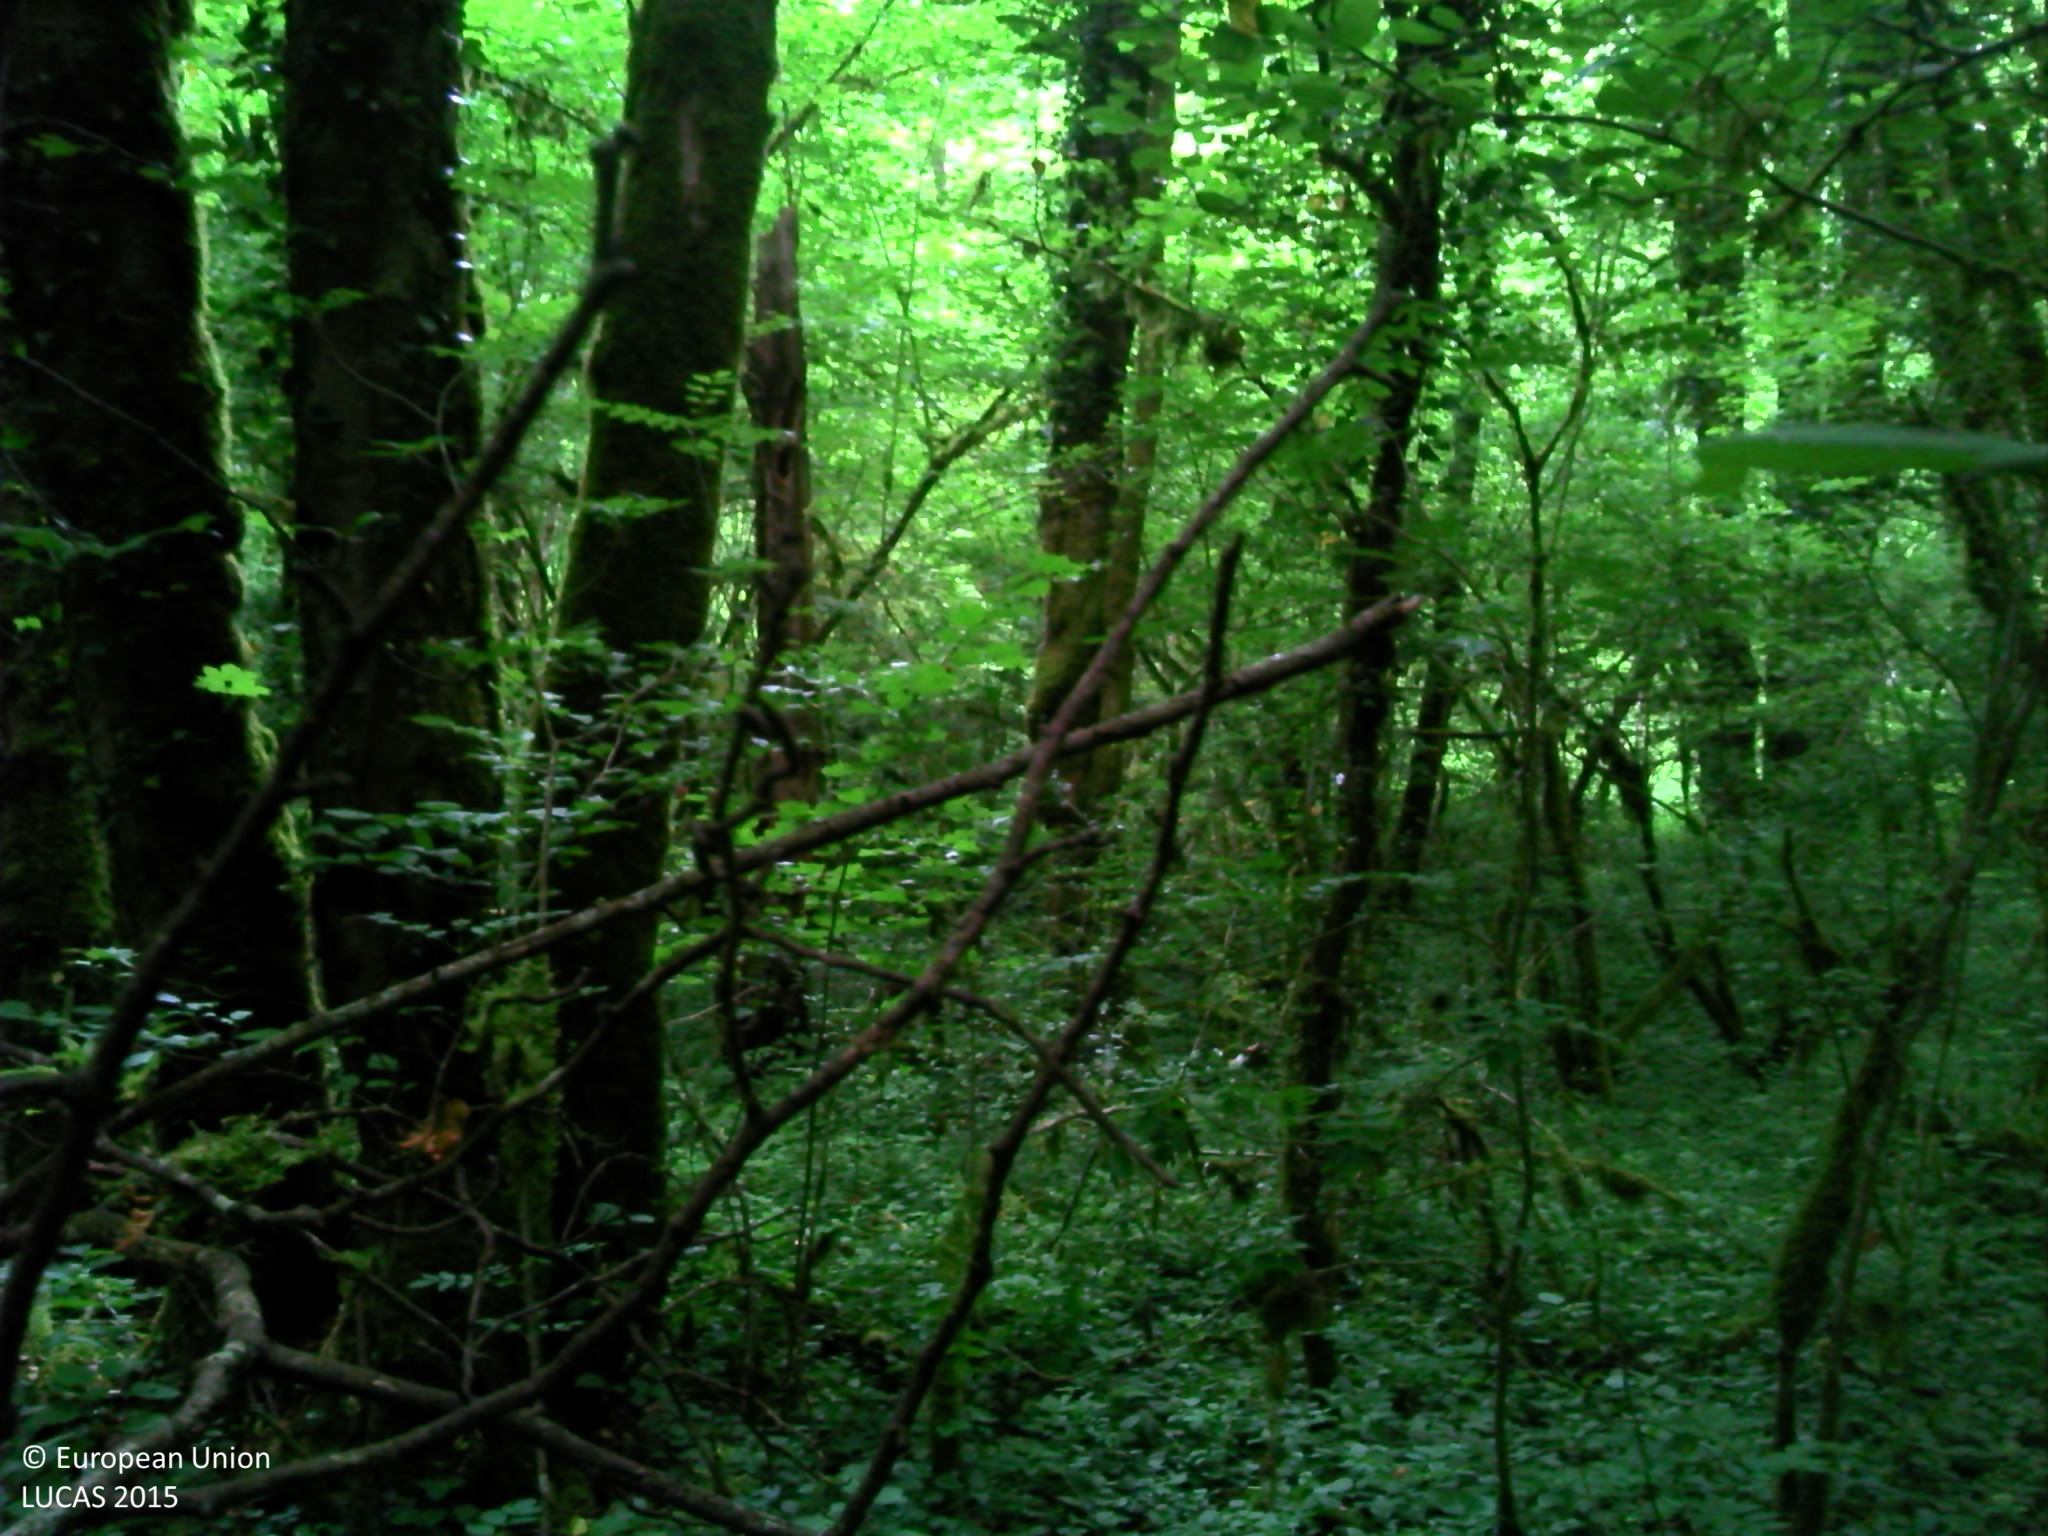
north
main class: Woodland
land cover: Broadleaved woodland
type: beech forest
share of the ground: > 75 %
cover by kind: broadleaved forest trees 90 %, herbaceous plants 10 %
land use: Forestry
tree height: > 5 m
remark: Harvested field
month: June
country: FR
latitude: 47.7285
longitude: 6.2813
